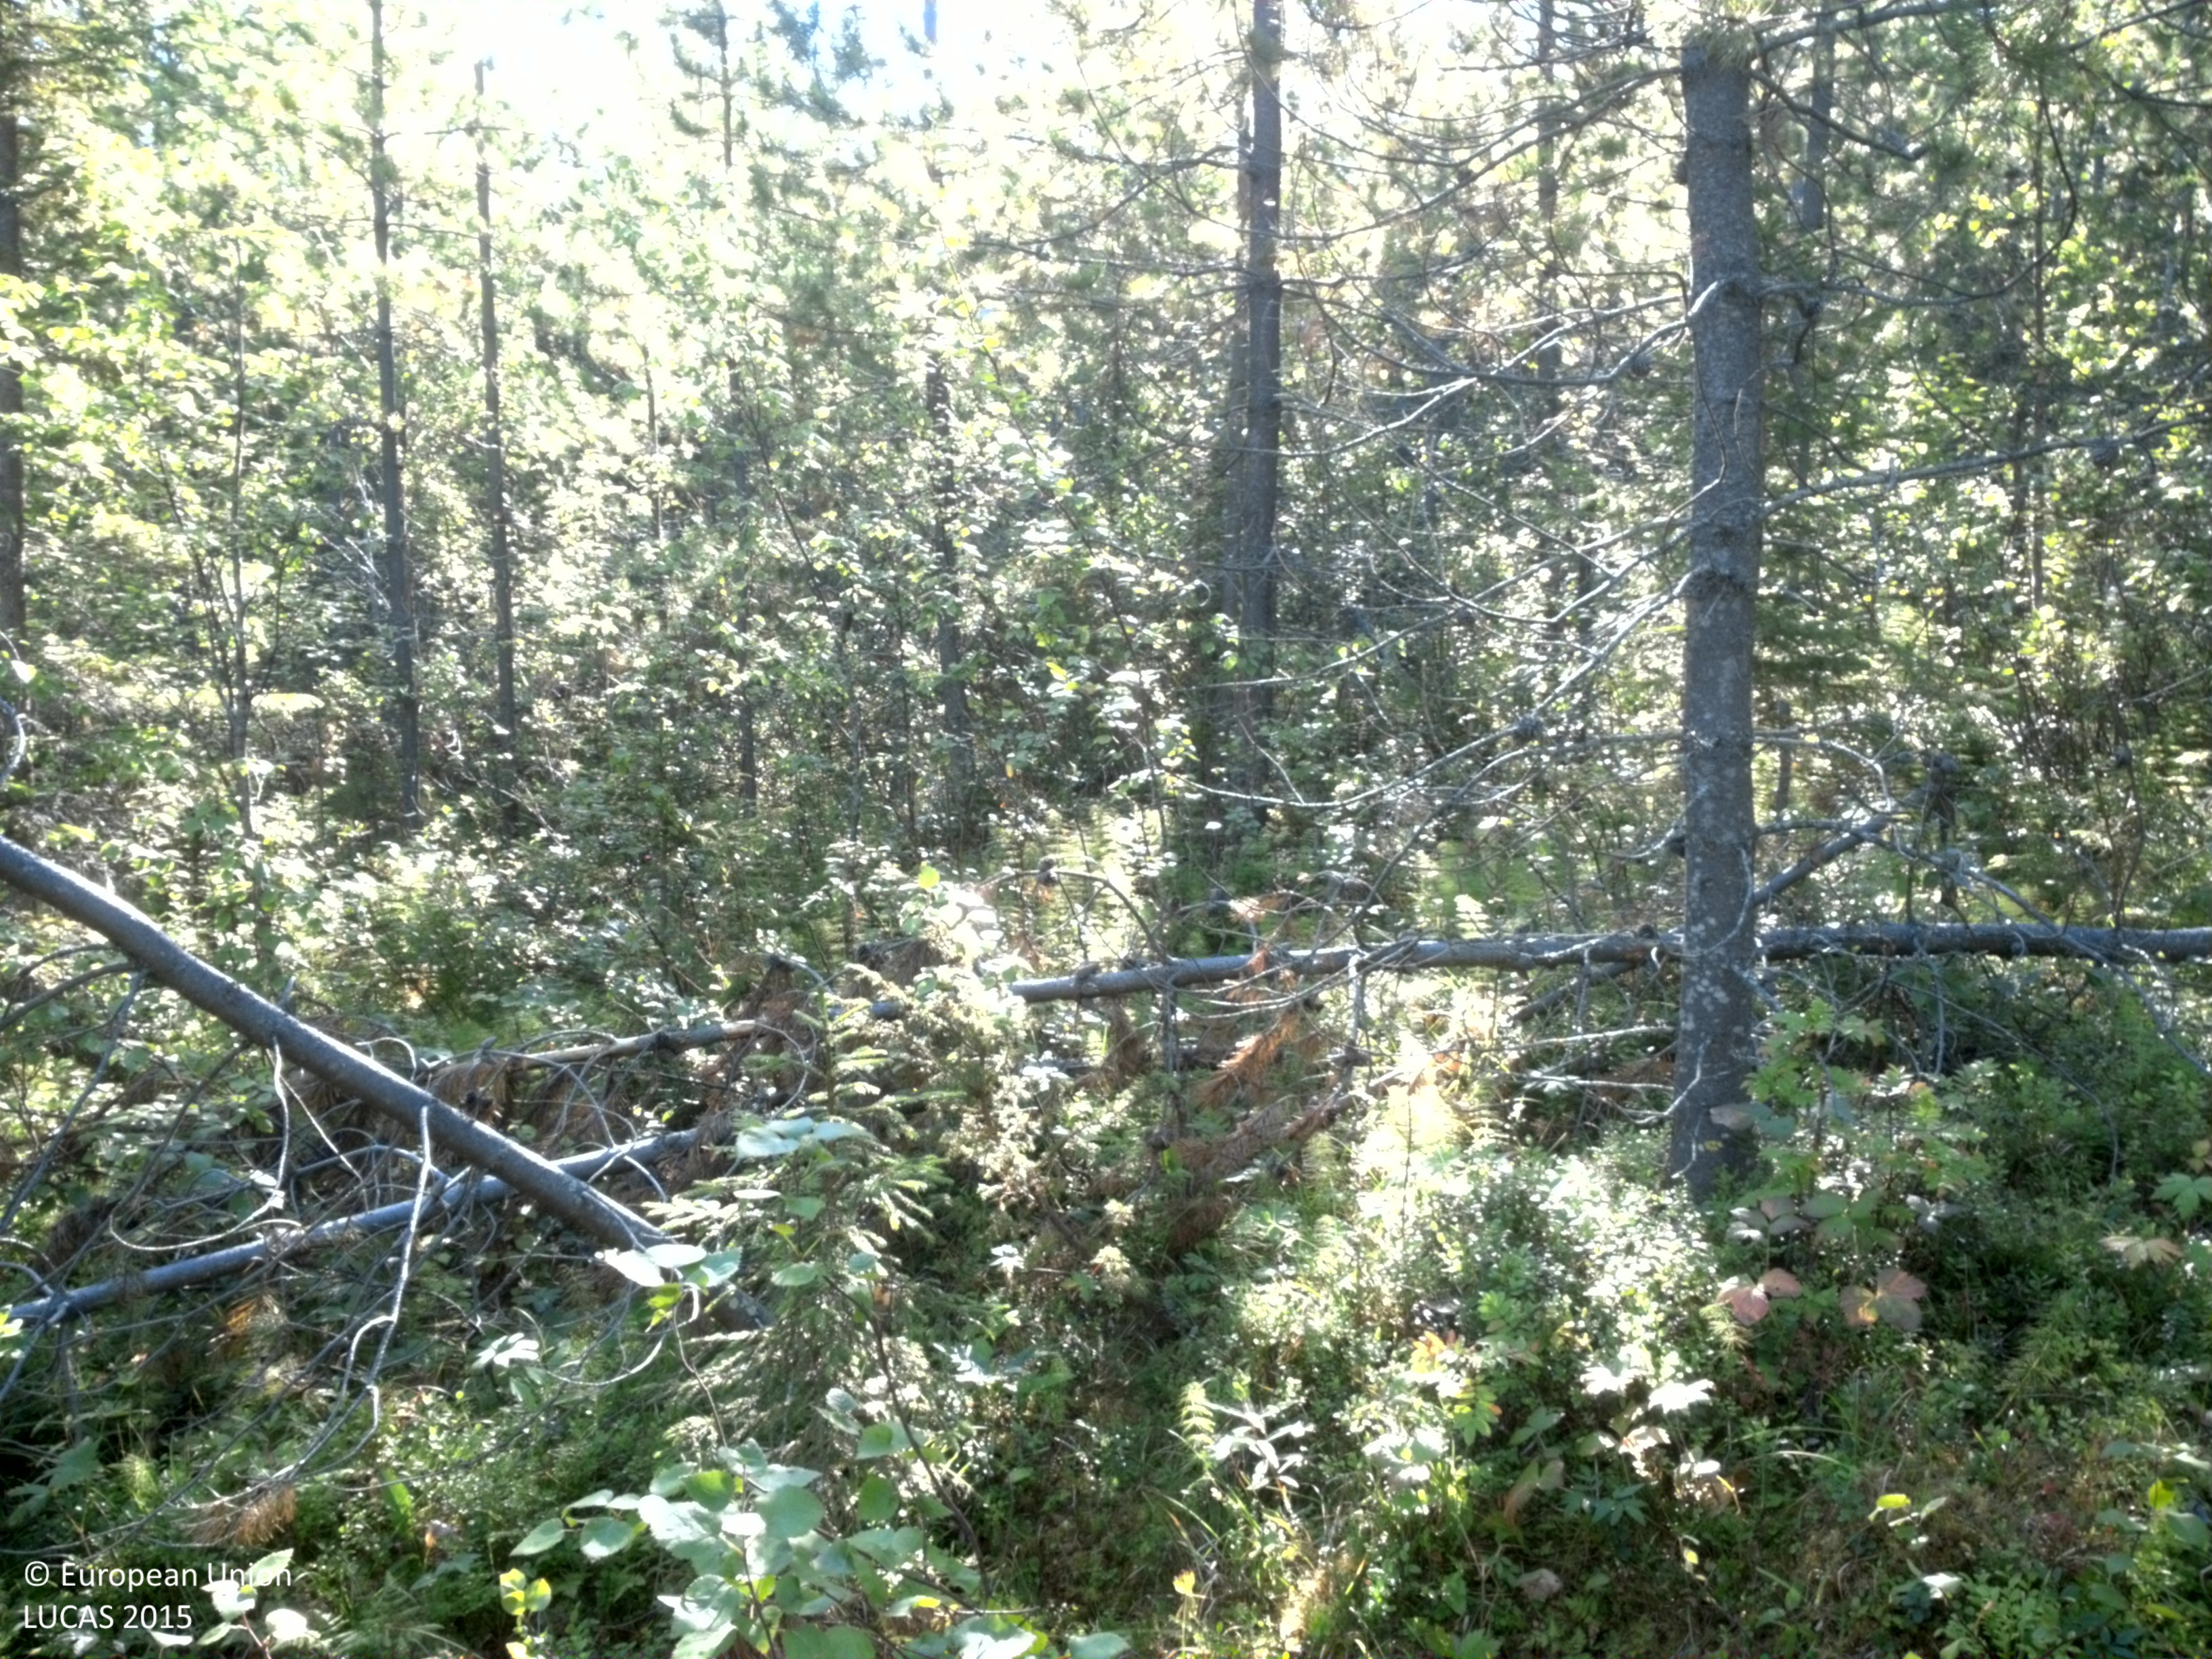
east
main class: Woodland
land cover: Pine dominated mixed woodland
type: exotic forest
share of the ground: 50 - 75 %
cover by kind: coniferous forest trees 45 %, shrubs 20 %, broadleaved forest trees 15 %, herbaceous plants 15 %, lichens and mosses 5 %
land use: Forestry
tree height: > 5 m
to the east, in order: Pine dominated mixed woodland
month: August
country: SE
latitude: 64.4648
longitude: 18.7642
